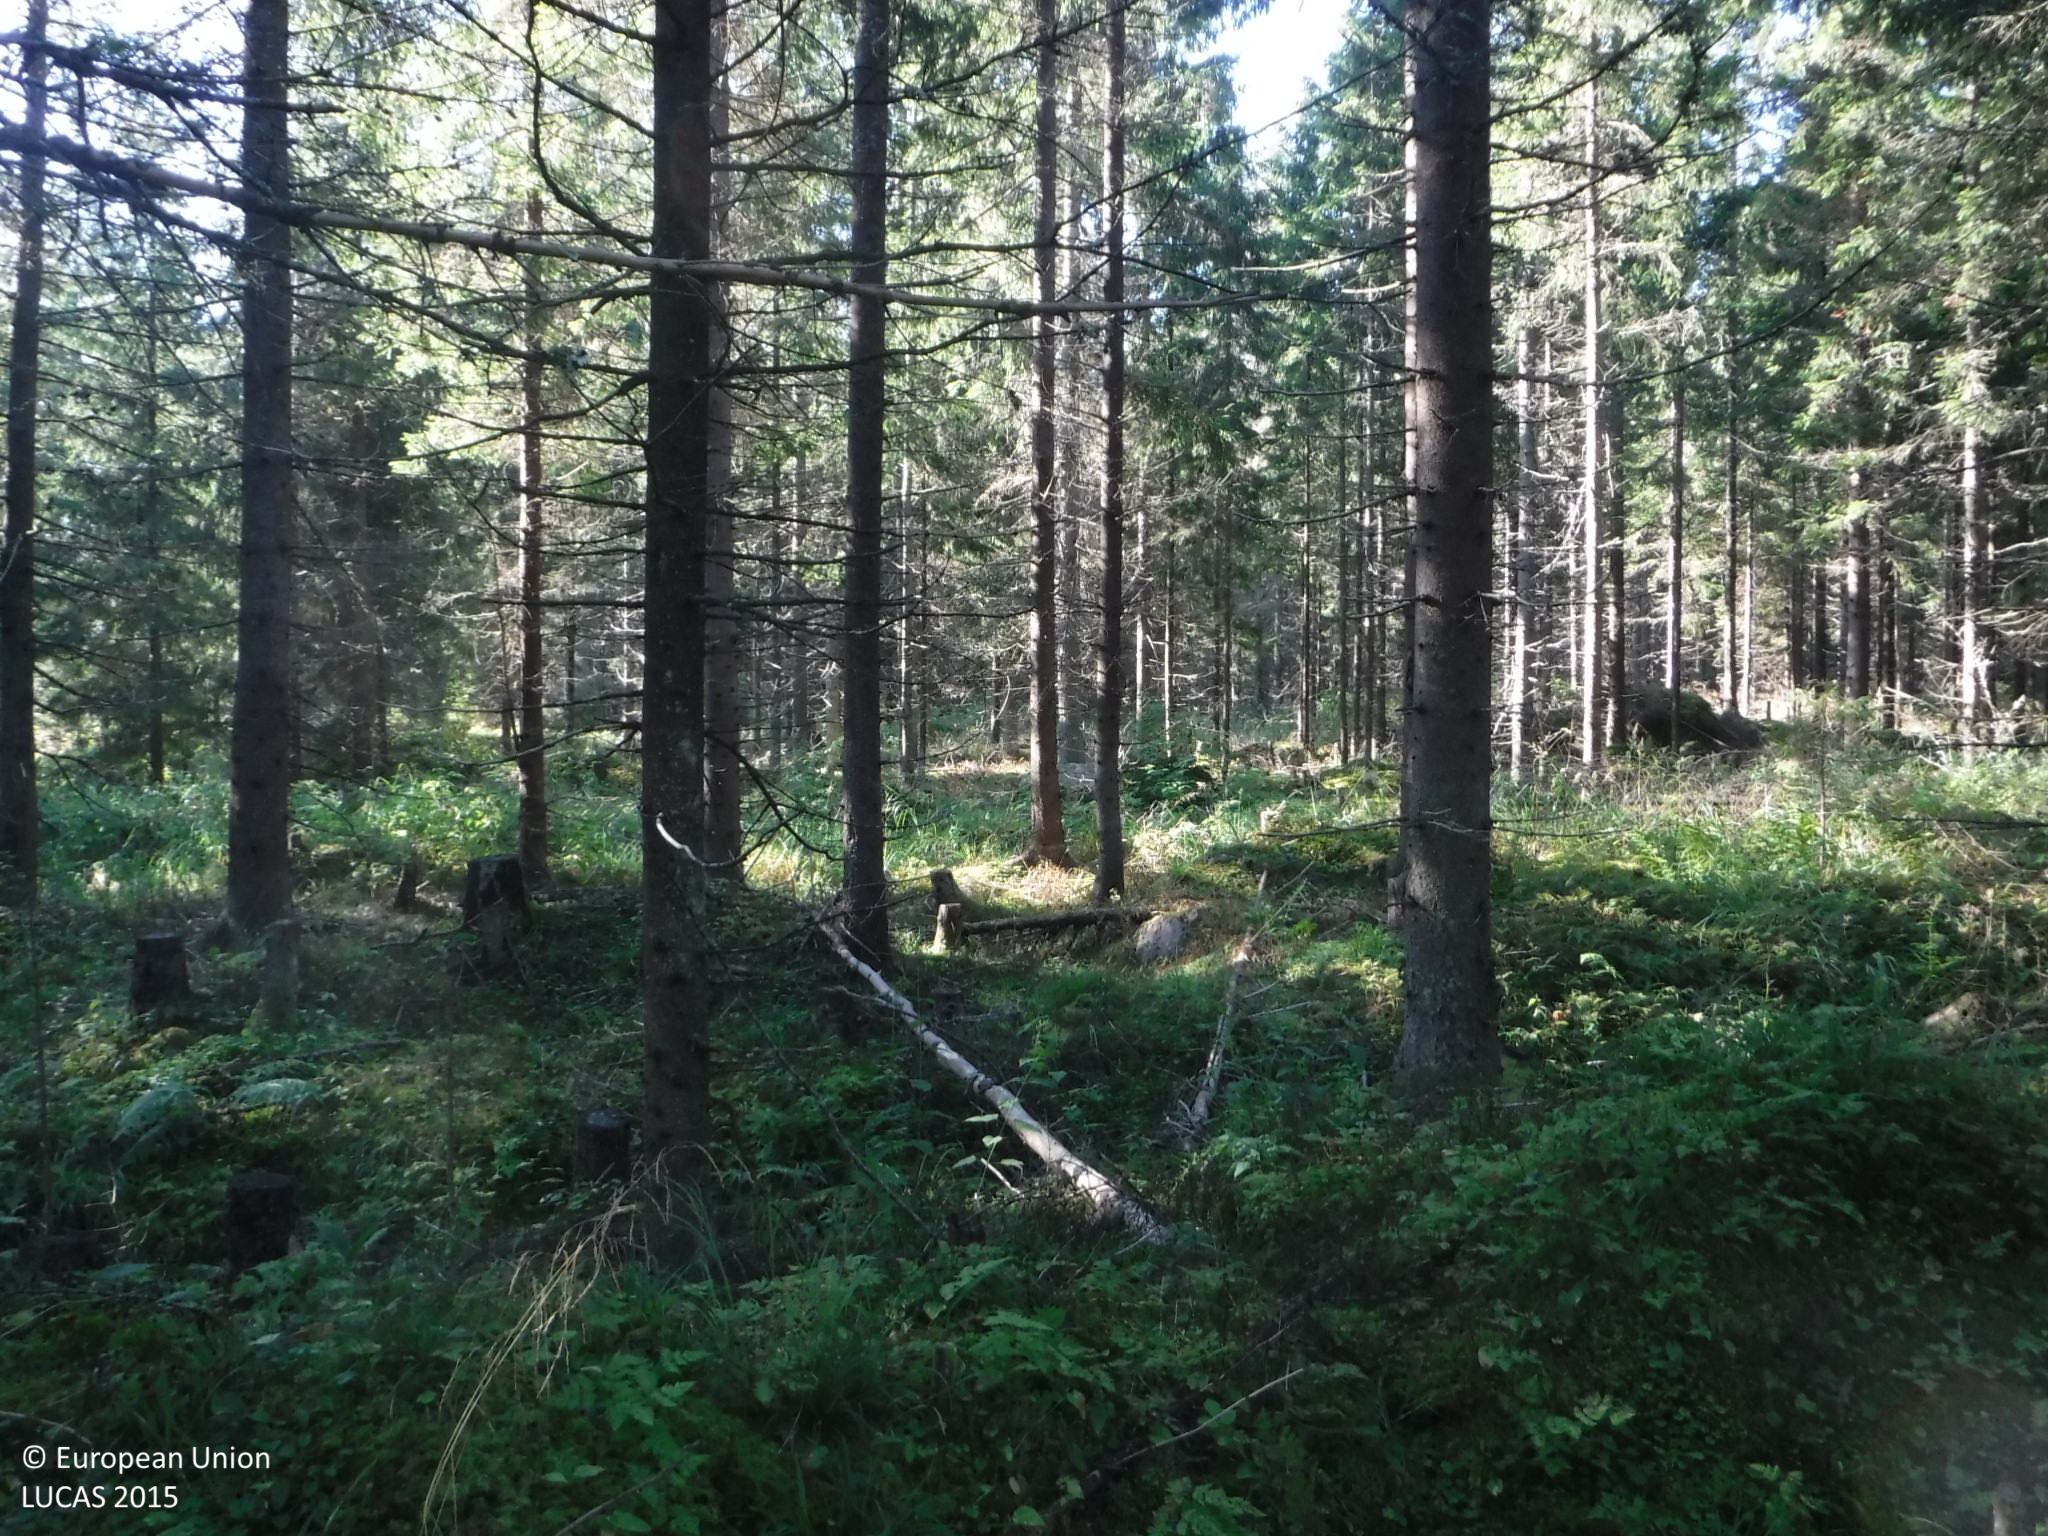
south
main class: Woodland
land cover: Spruce dominated coniferous woodland
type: boreal forest
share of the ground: 50 - 75 %
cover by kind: coniferous forest trees 50 %, herbaceous plants 30 %, shrubs 10 %, lichens and mosses 10 %
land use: Forestry
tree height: > 5 m
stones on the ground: < 10 %
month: August
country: FI
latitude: 61.2596
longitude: 21.7065
